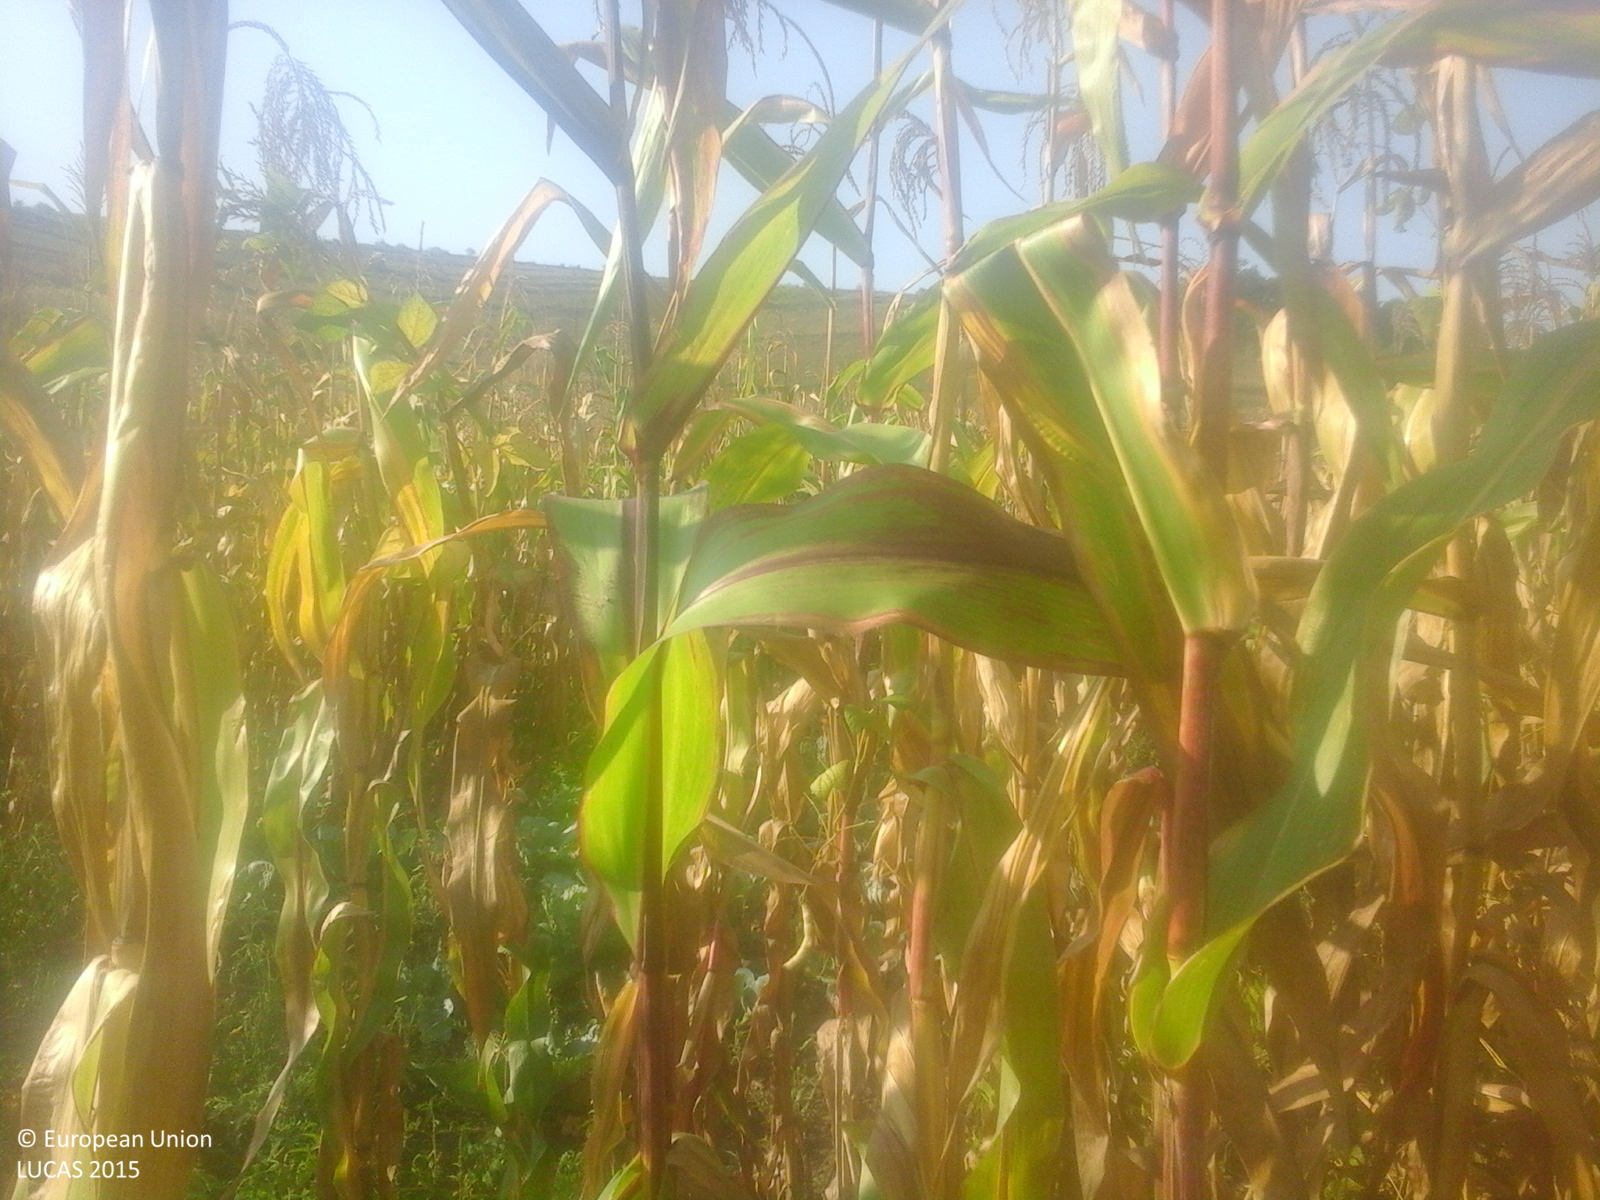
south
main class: Cropland
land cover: Maize
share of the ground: > 75 %
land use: Agriculture (excluding fallow land and kitchen gardens)
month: September
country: RO
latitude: 46.8592
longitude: 24.4779
